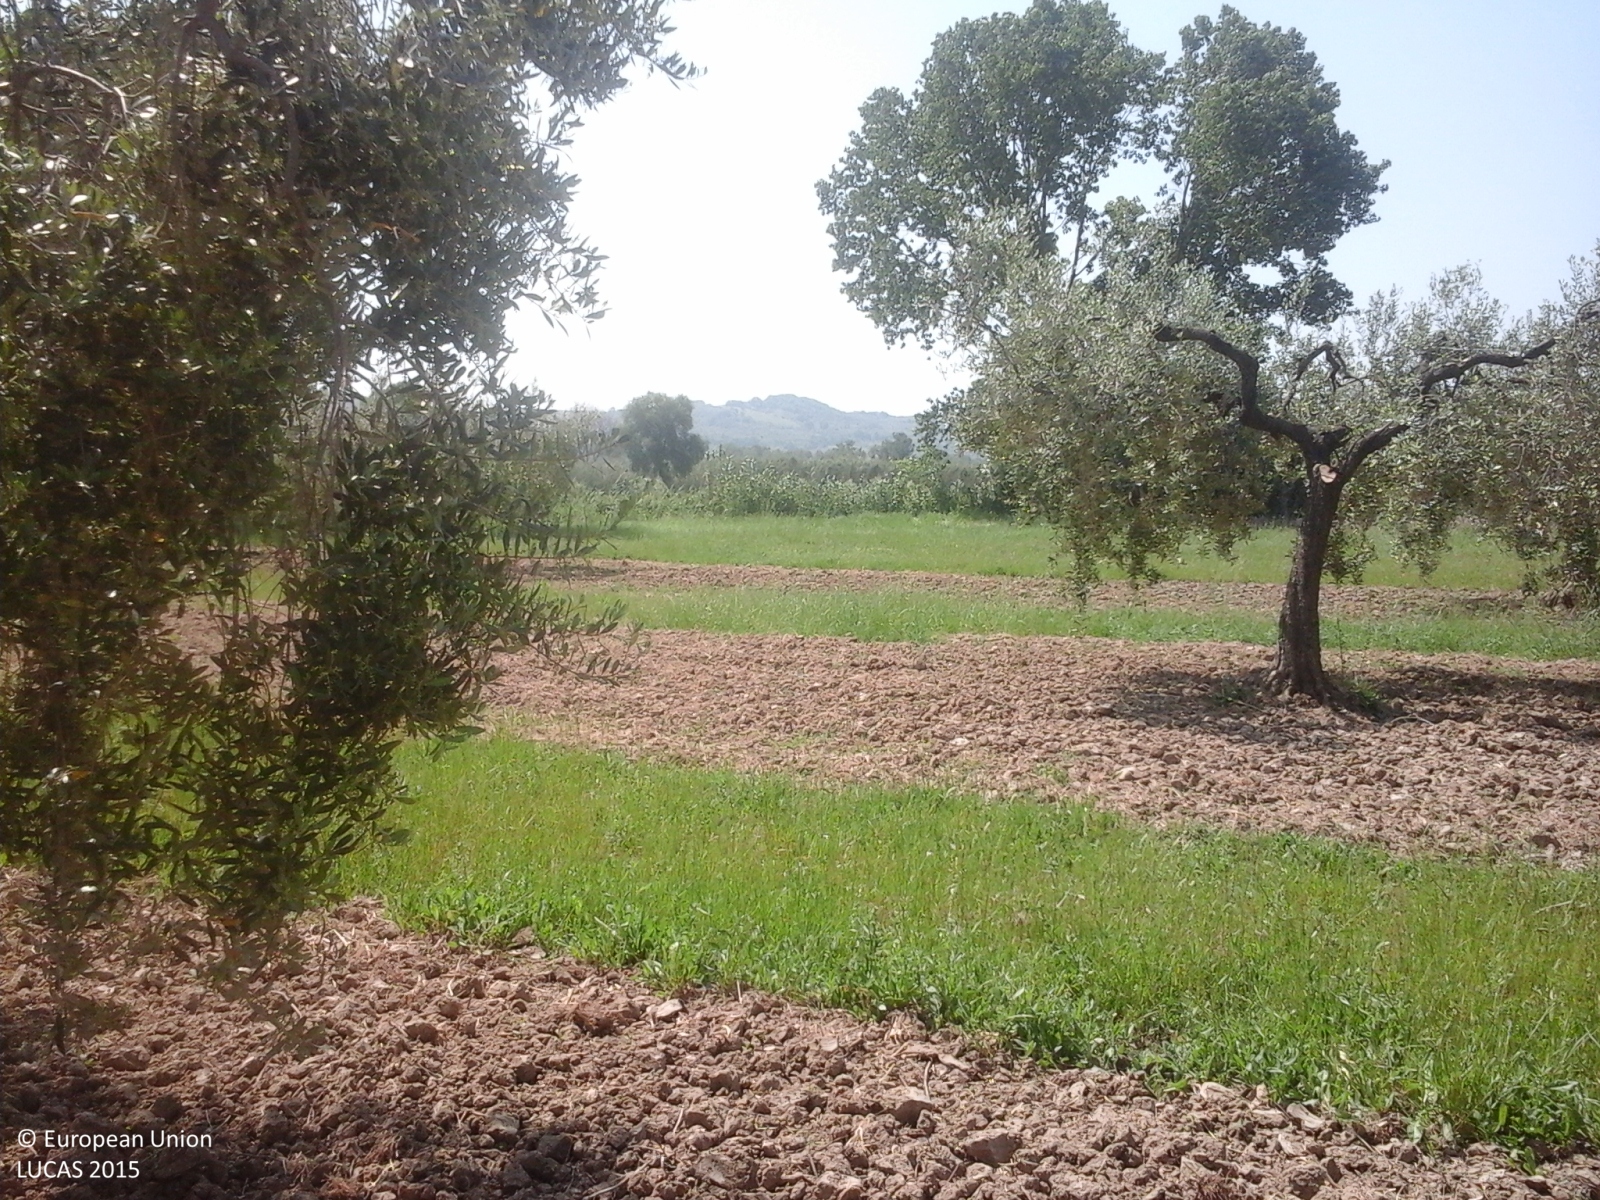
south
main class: Cropland
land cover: Olive groves
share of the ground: 25 - 50 %
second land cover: Other bare soil
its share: > 75 %
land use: Agriculture (excluding fallow land and kitchen gardens)
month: May
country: IT
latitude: 42.2101
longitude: 14.5044
